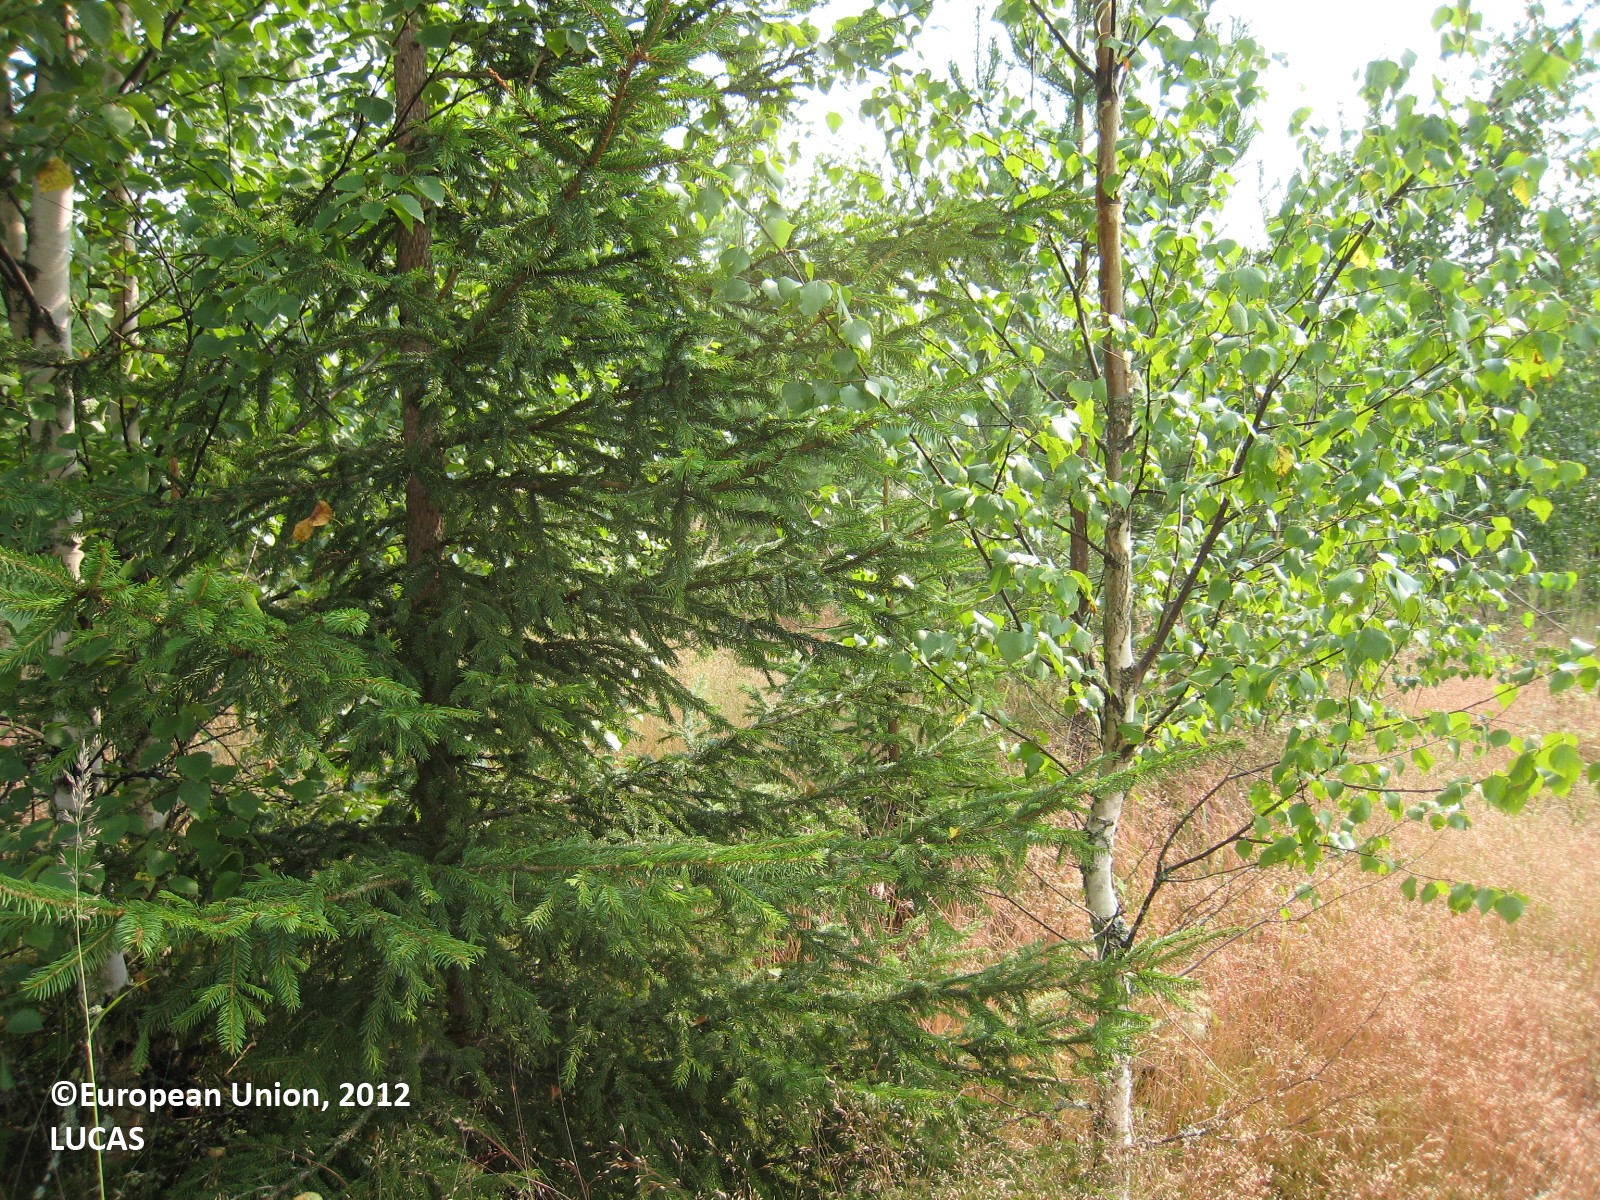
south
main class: Woodland
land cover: Other mixed woodland
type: boreal forest
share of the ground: 50 - 75 %
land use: Forestry
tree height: < 5 m
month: July
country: FI
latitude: 62.4066
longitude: 27.3682
